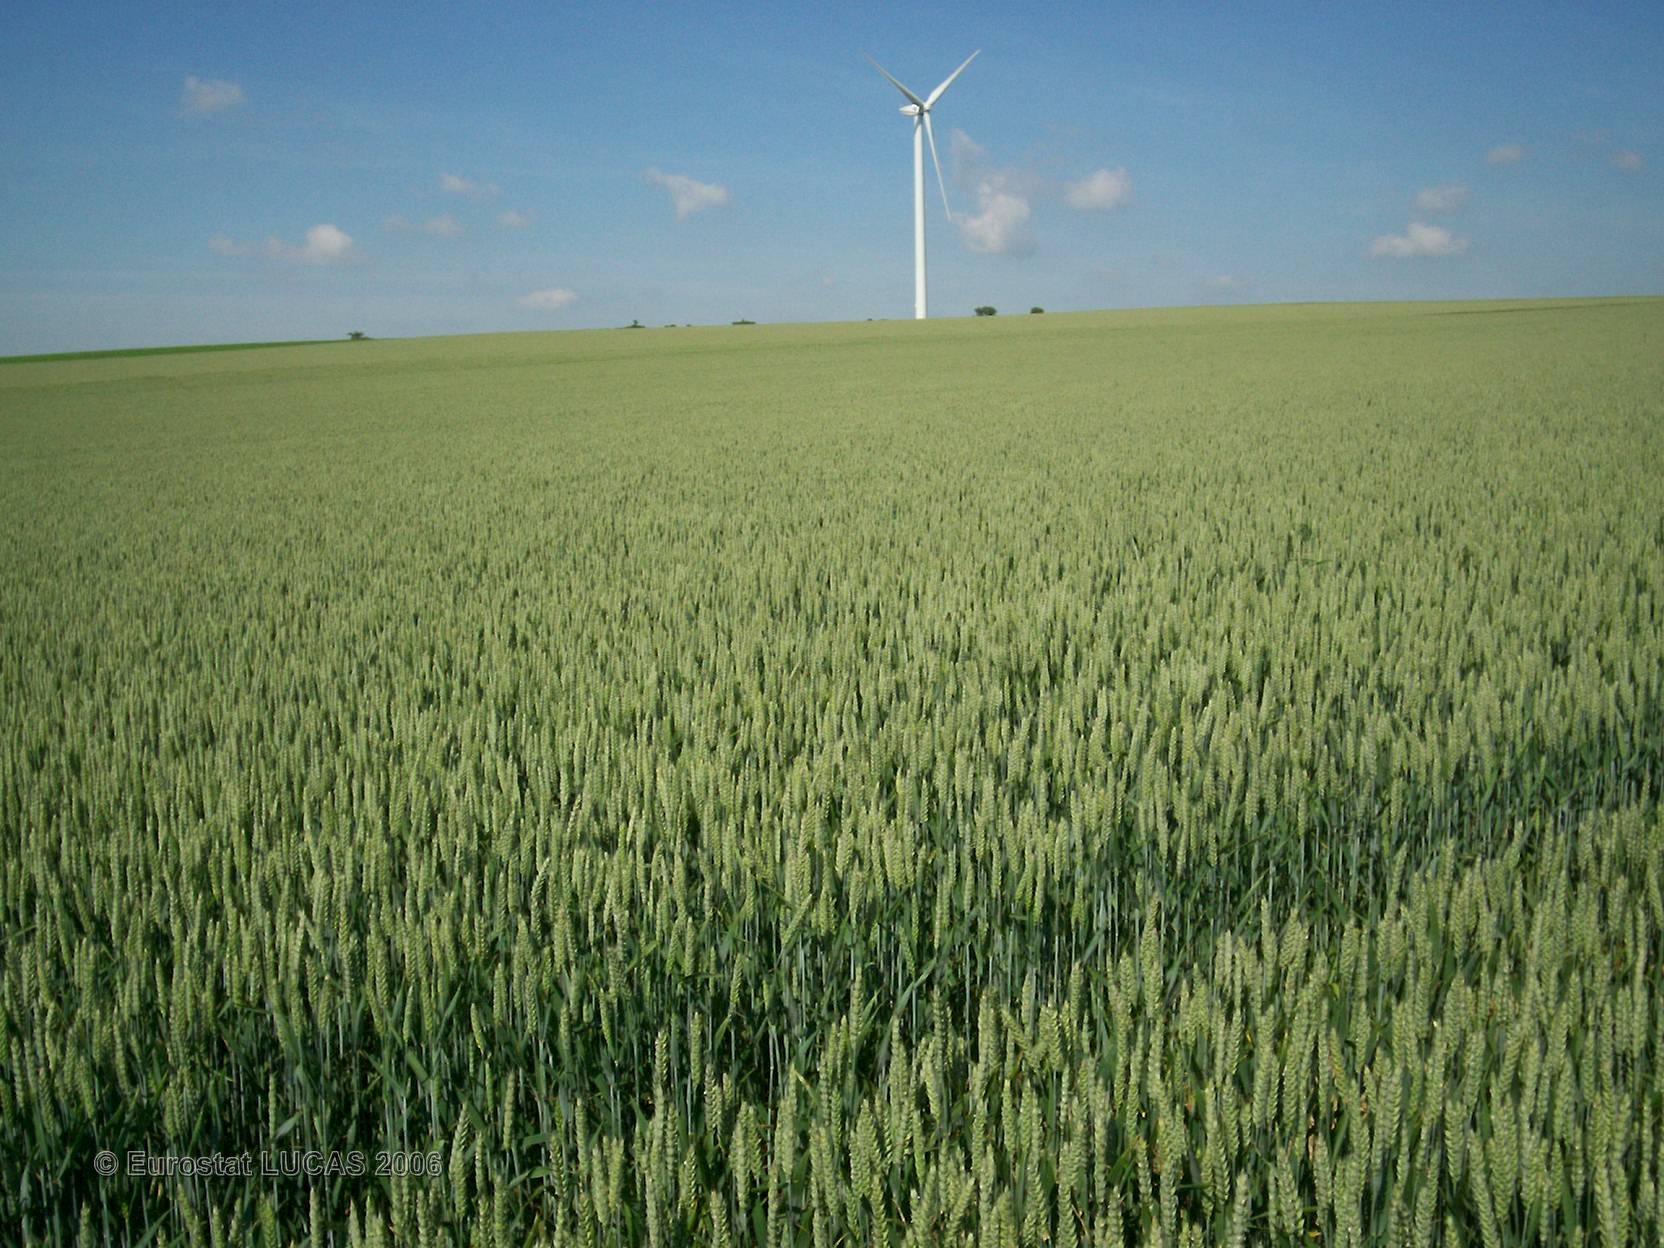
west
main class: Cropland
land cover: Common wheat
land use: Agriculture (excluding fallow land and kitchen gardens)
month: June
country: FR
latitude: 48.8206
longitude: 4.3988
